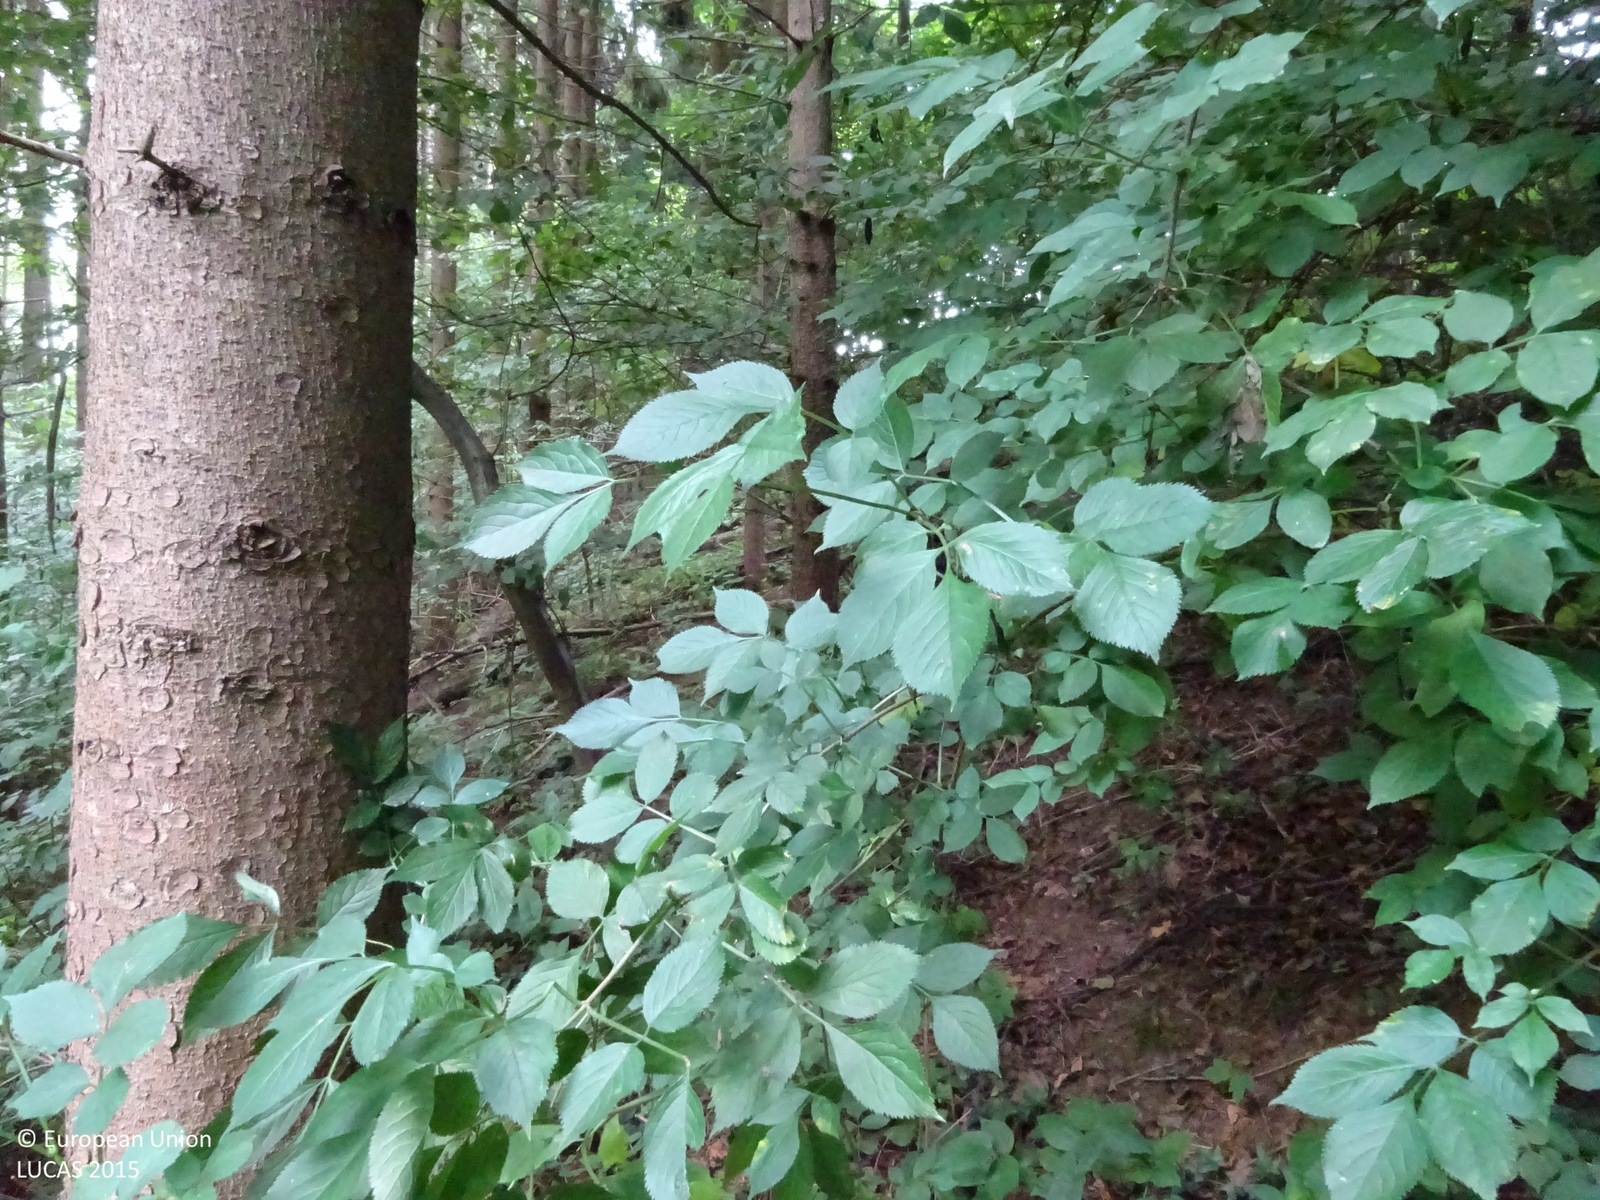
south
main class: Woodland
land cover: Spruce dominated mixed woodland
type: mountainous beech forest
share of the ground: > 75 %
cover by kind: broadleaved forest trees 65 %, coniferous forest trees 25 %, shrubs 10 %
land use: Forestry
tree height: > 5 m
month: July
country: AT
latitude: 46.9273
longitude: 15.9238
